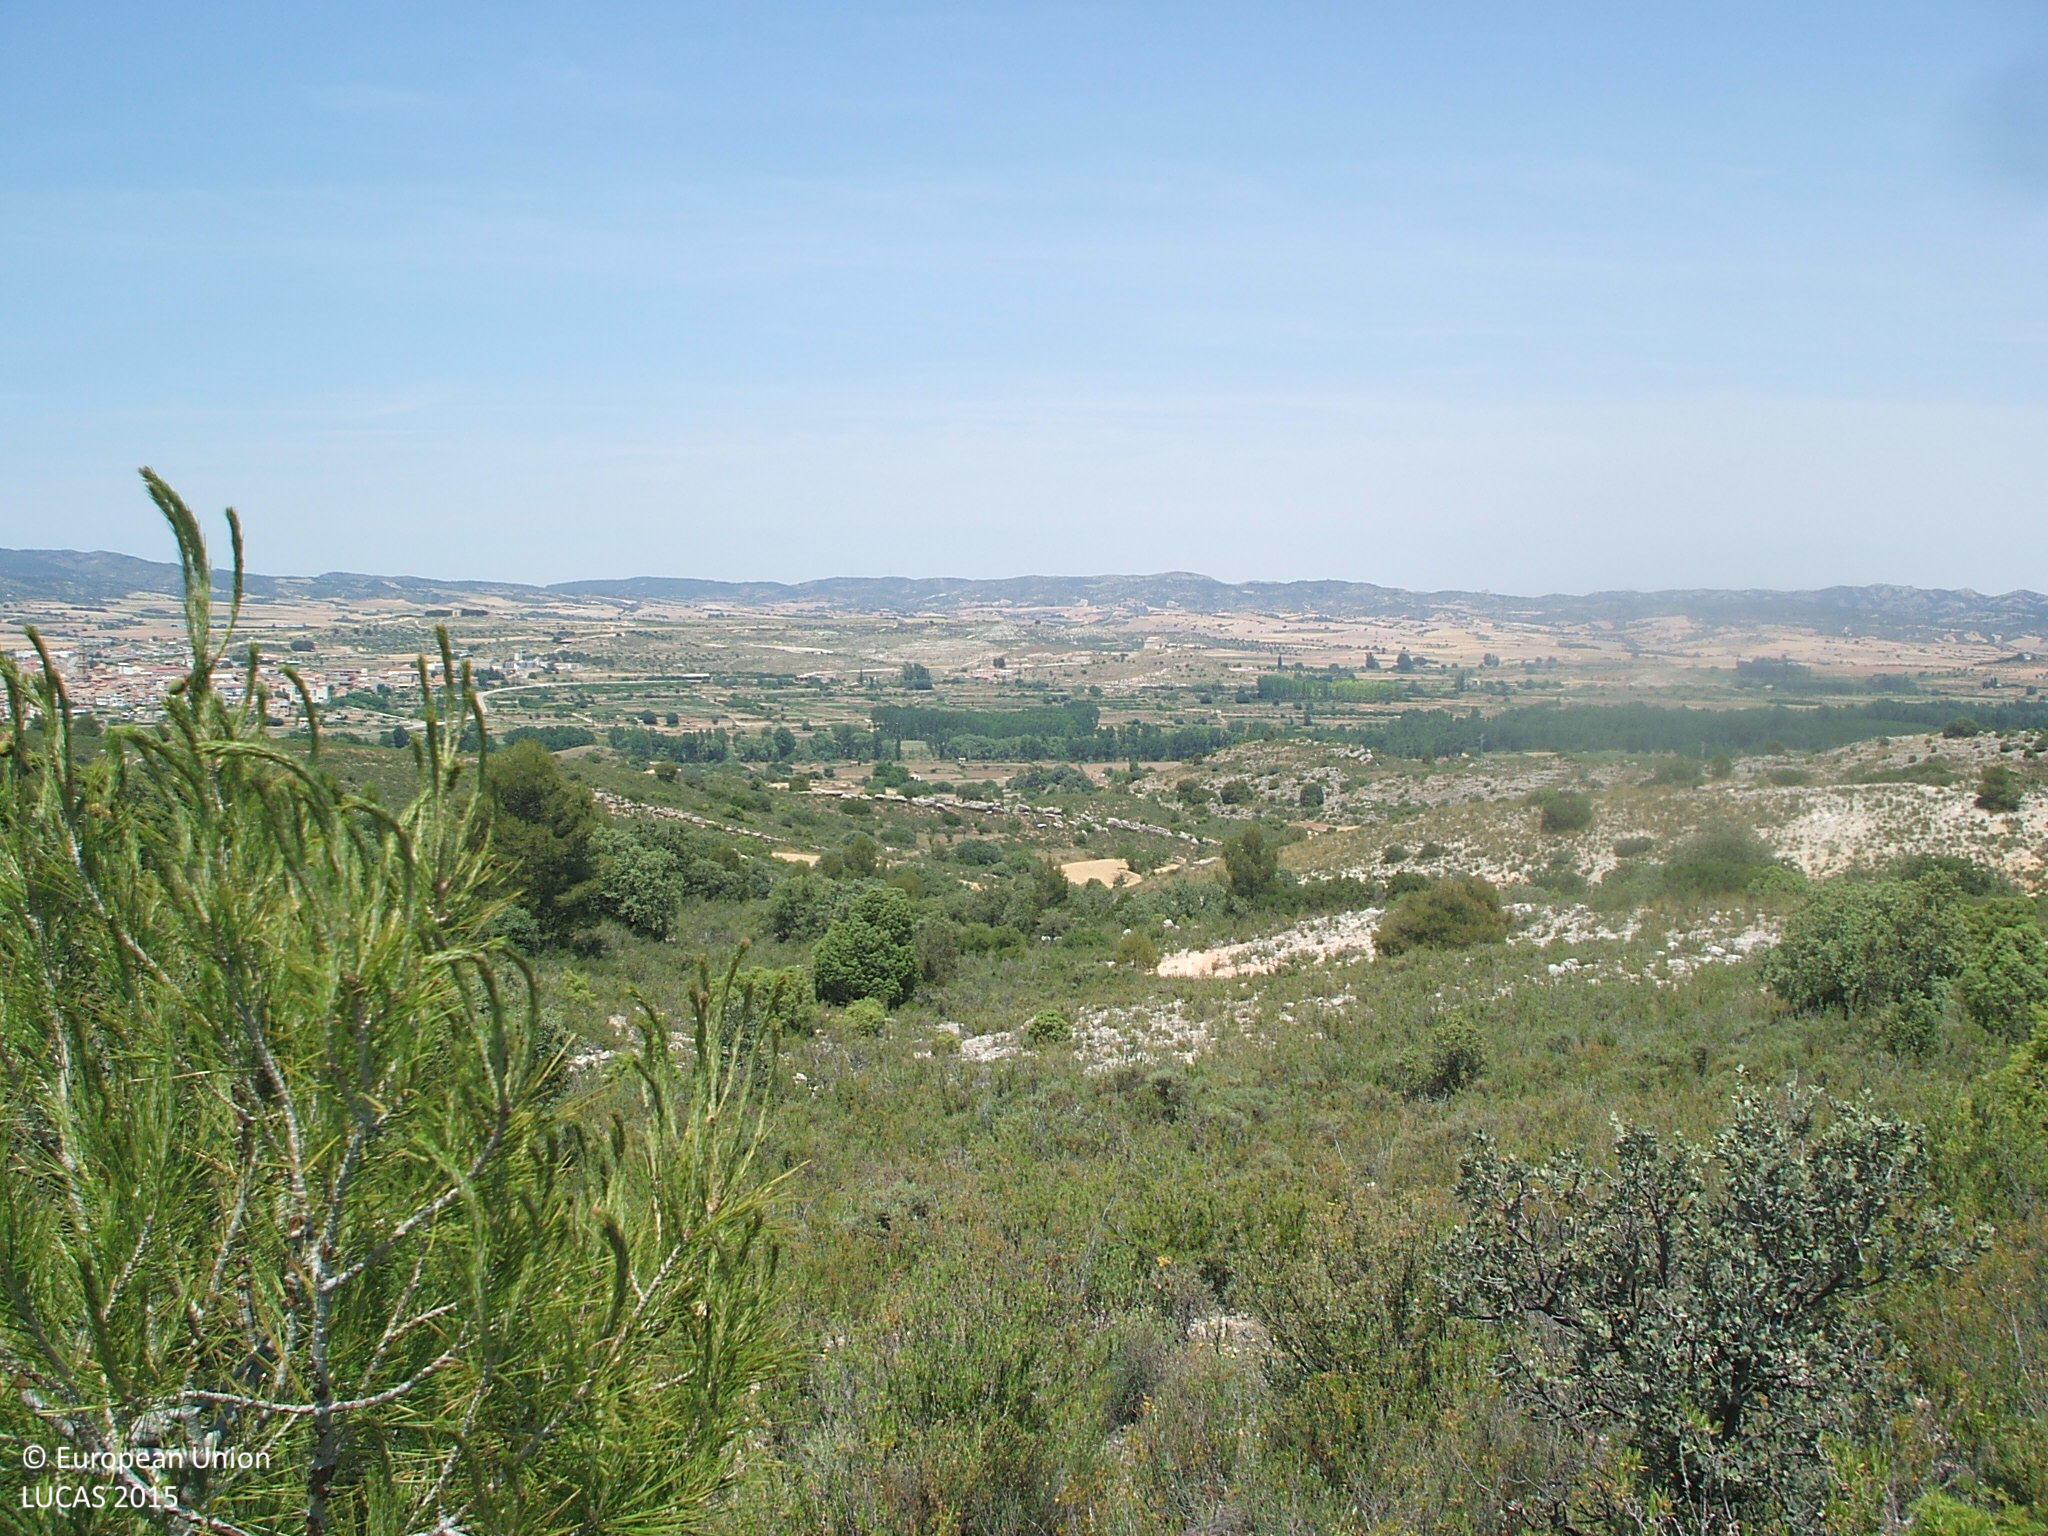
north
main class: Shrubland
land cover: Shrubland with sparse tree cover
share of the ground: > 75 %
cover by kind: shrubs 80 %, consolidated bare surface 15 %, coniferous forest trees 5 %
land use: Semi-natural and natural areas not in use
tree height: > 5 m
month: June
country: ES
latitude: 40.8254
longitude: -0.2189
